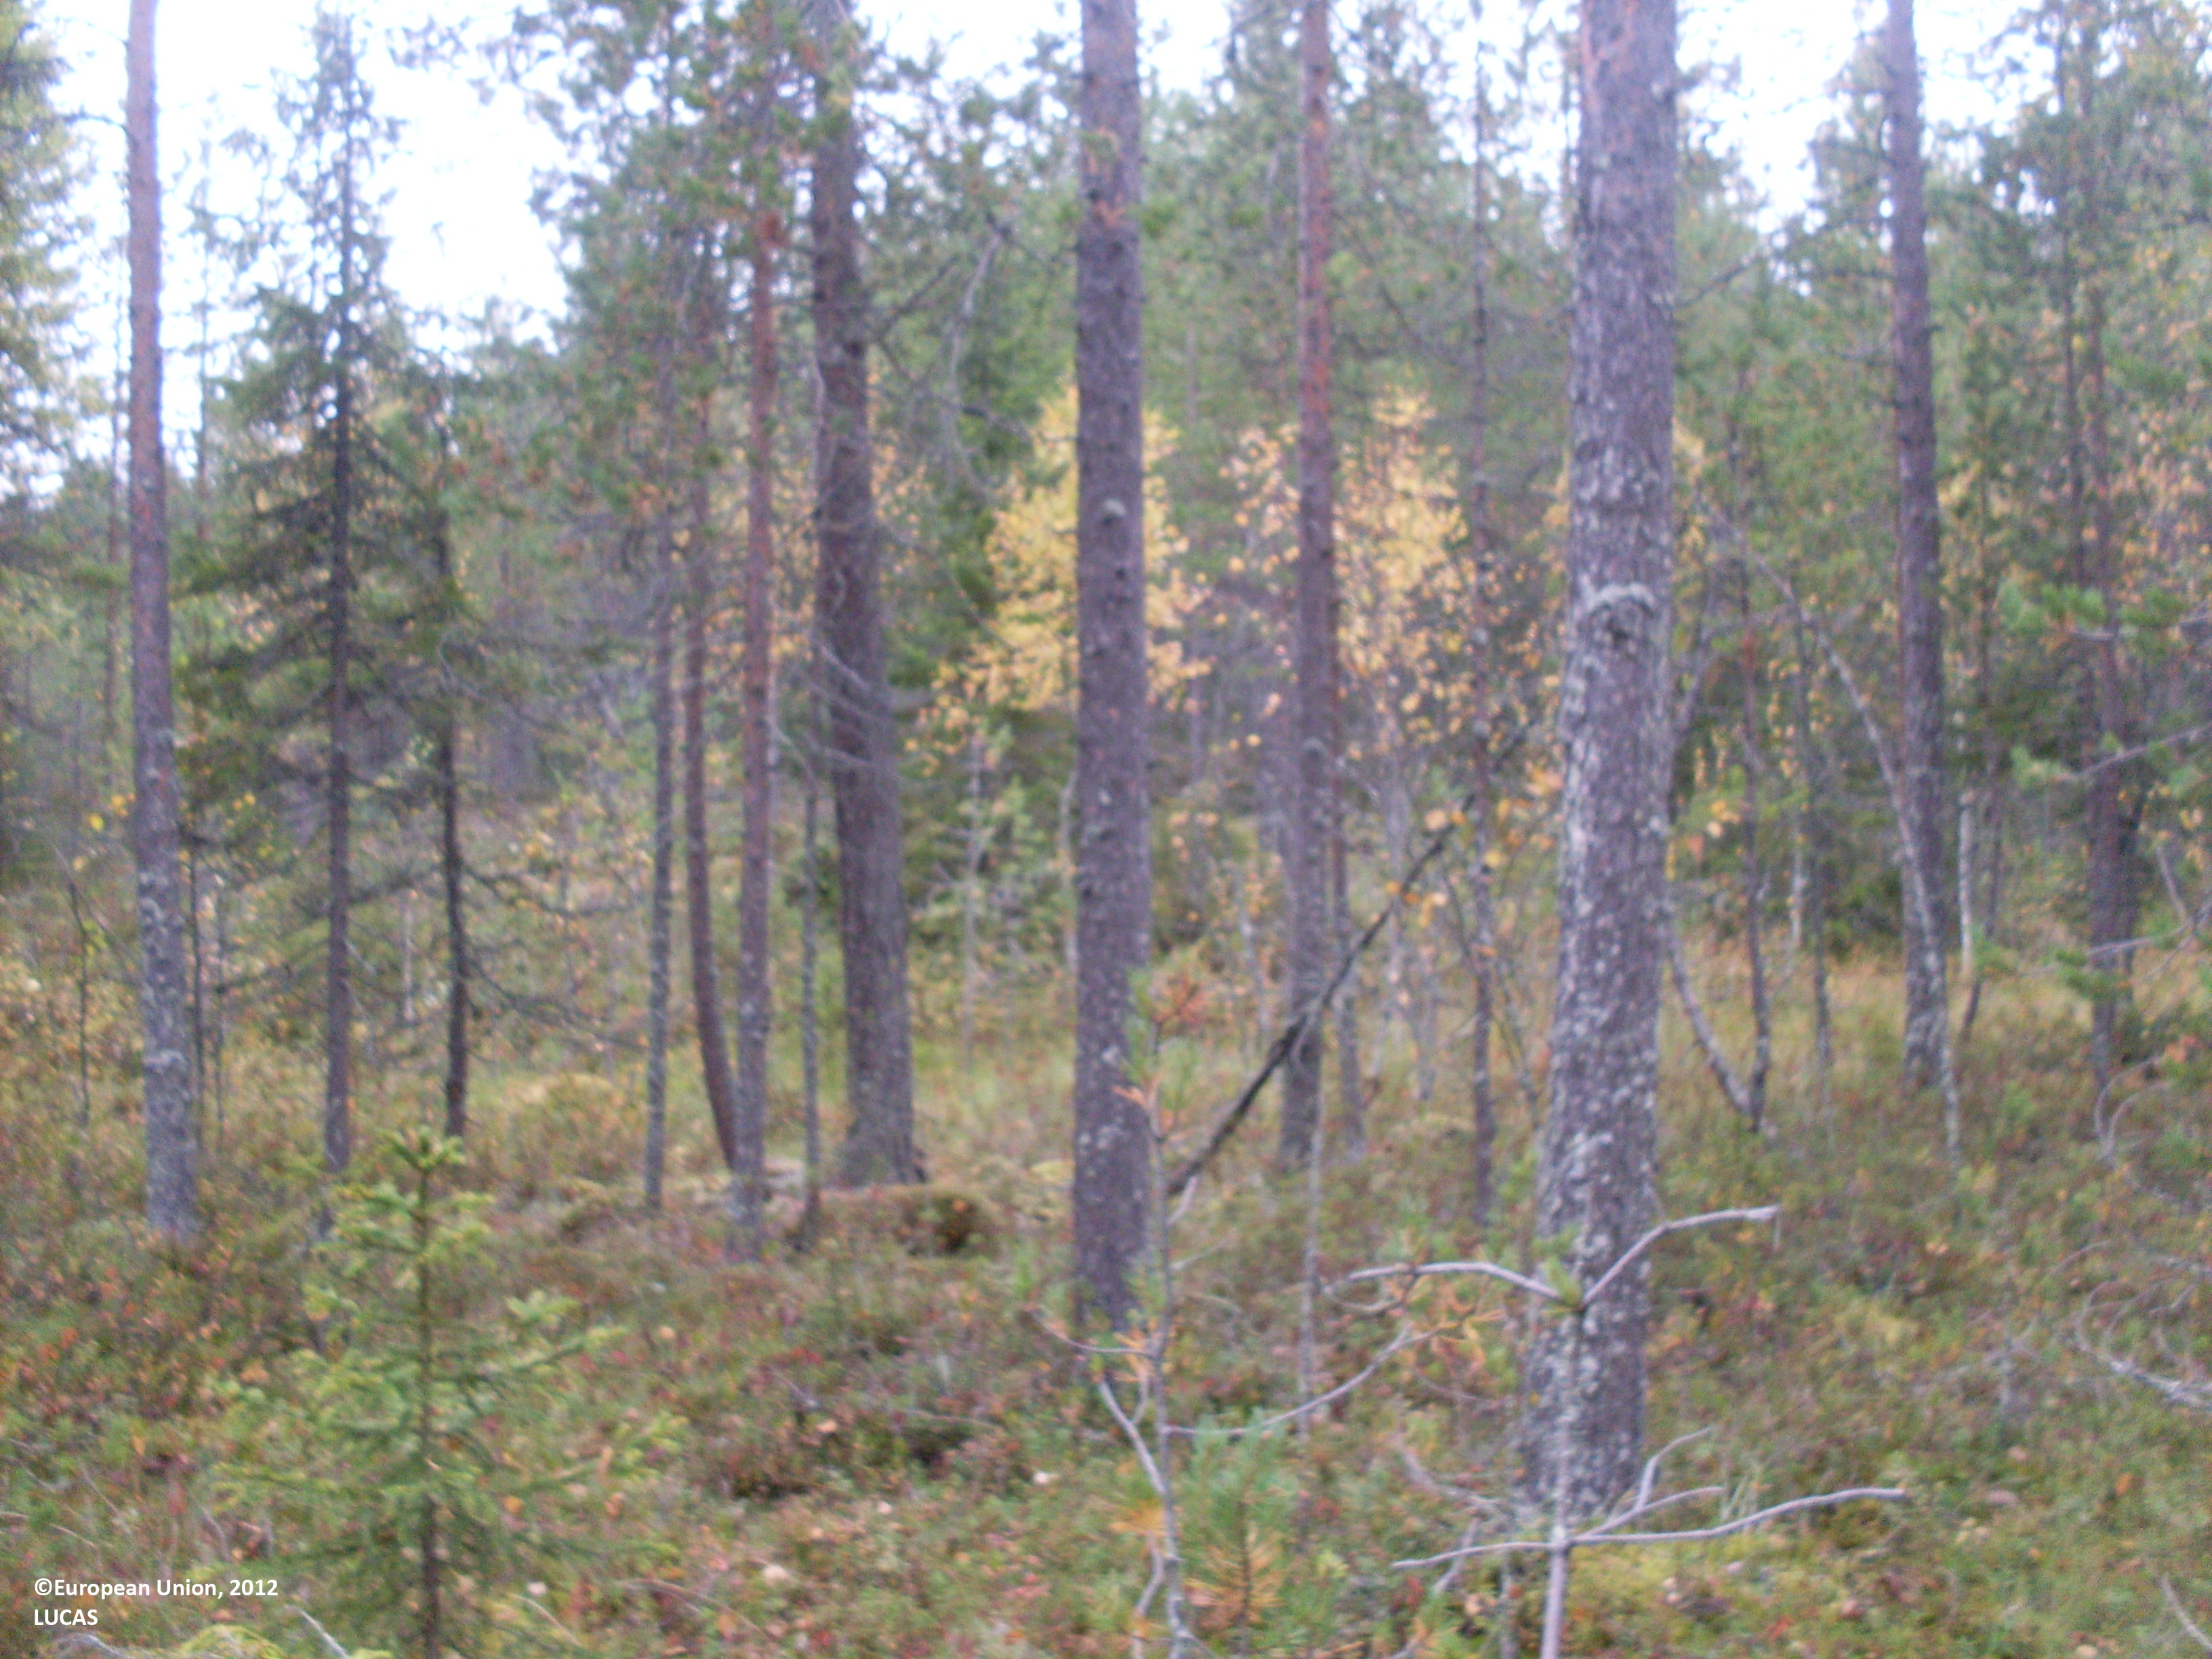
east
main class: Woodland
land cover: Pine dominated coniferous woodland
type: boreal forest
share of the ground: 50 - 75 %
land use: Forestry
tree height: > 5 m
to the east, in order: Pine dominated coniferous woodland; Spruce dominated mixed woodland
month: September
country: FI
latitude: 64.2021
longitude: 29.4725
